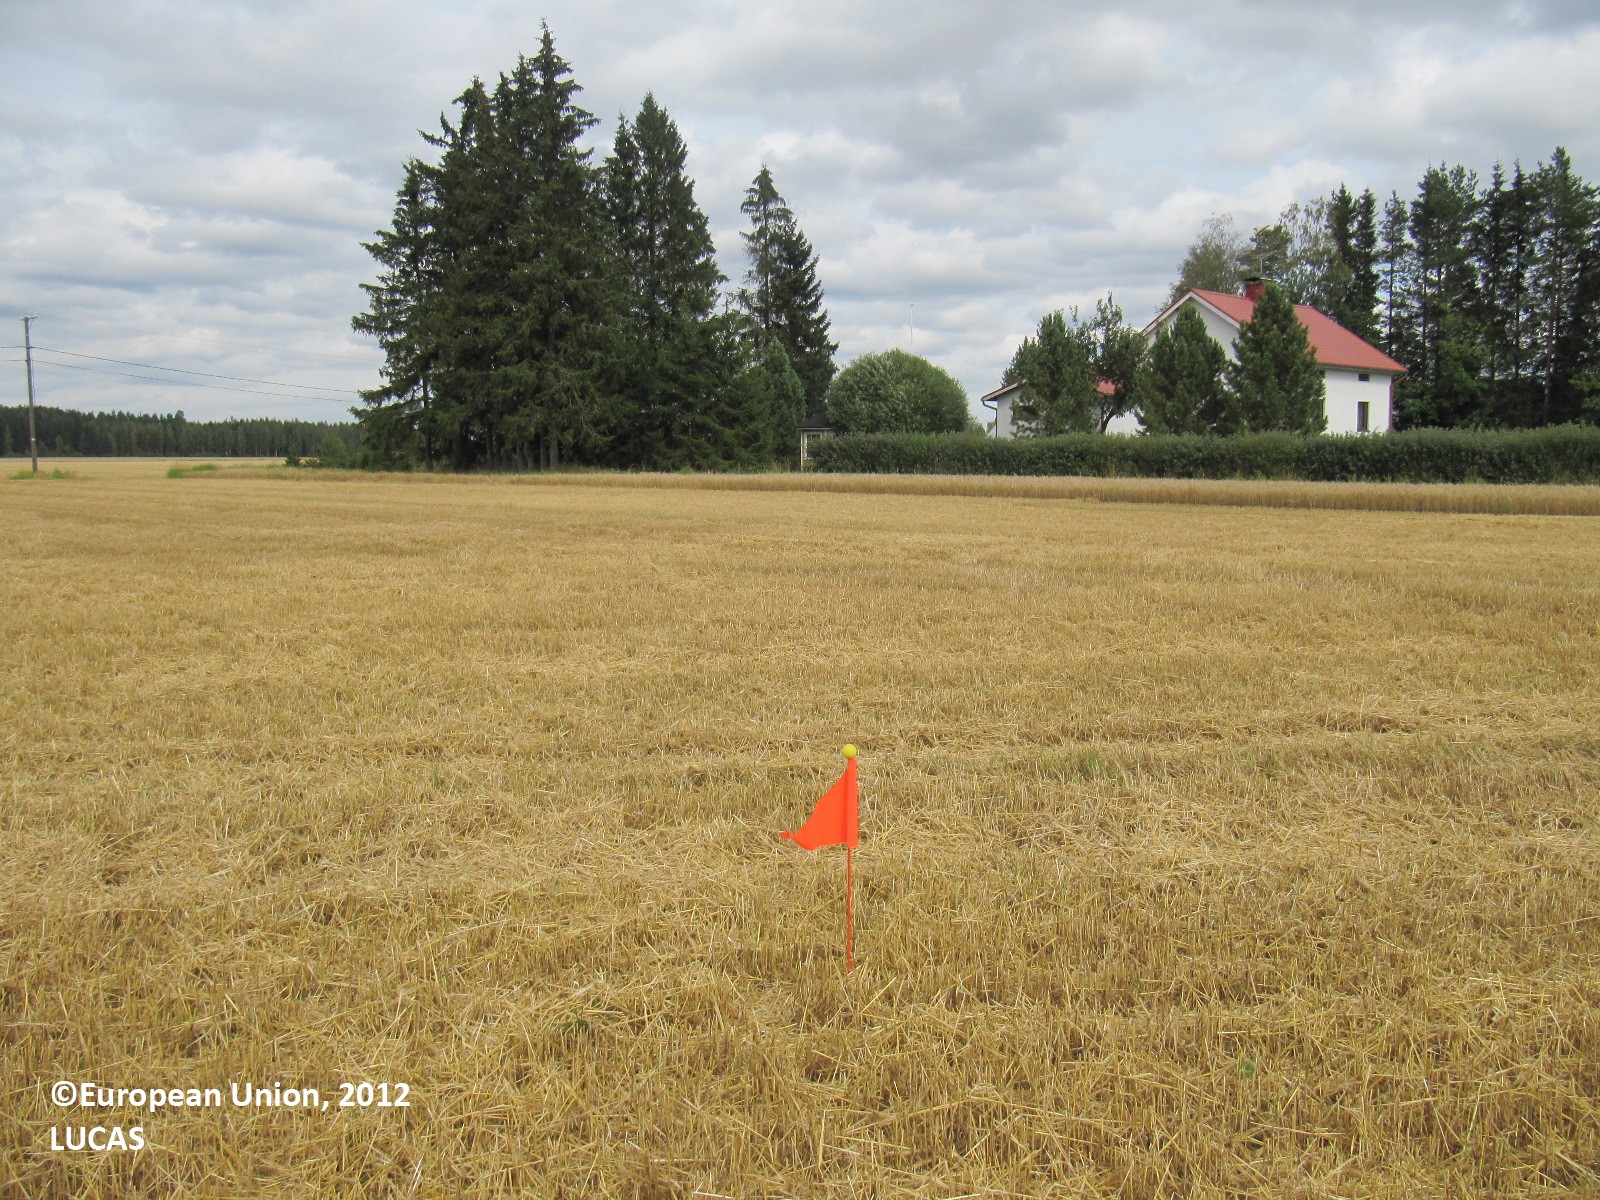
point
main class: Cropland
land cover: Barley
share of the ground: > 75 %
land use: Agriculture (excluding fallow land and kitchen gardens)
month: August
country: FI
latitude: 60.9028
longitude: 22.8855
